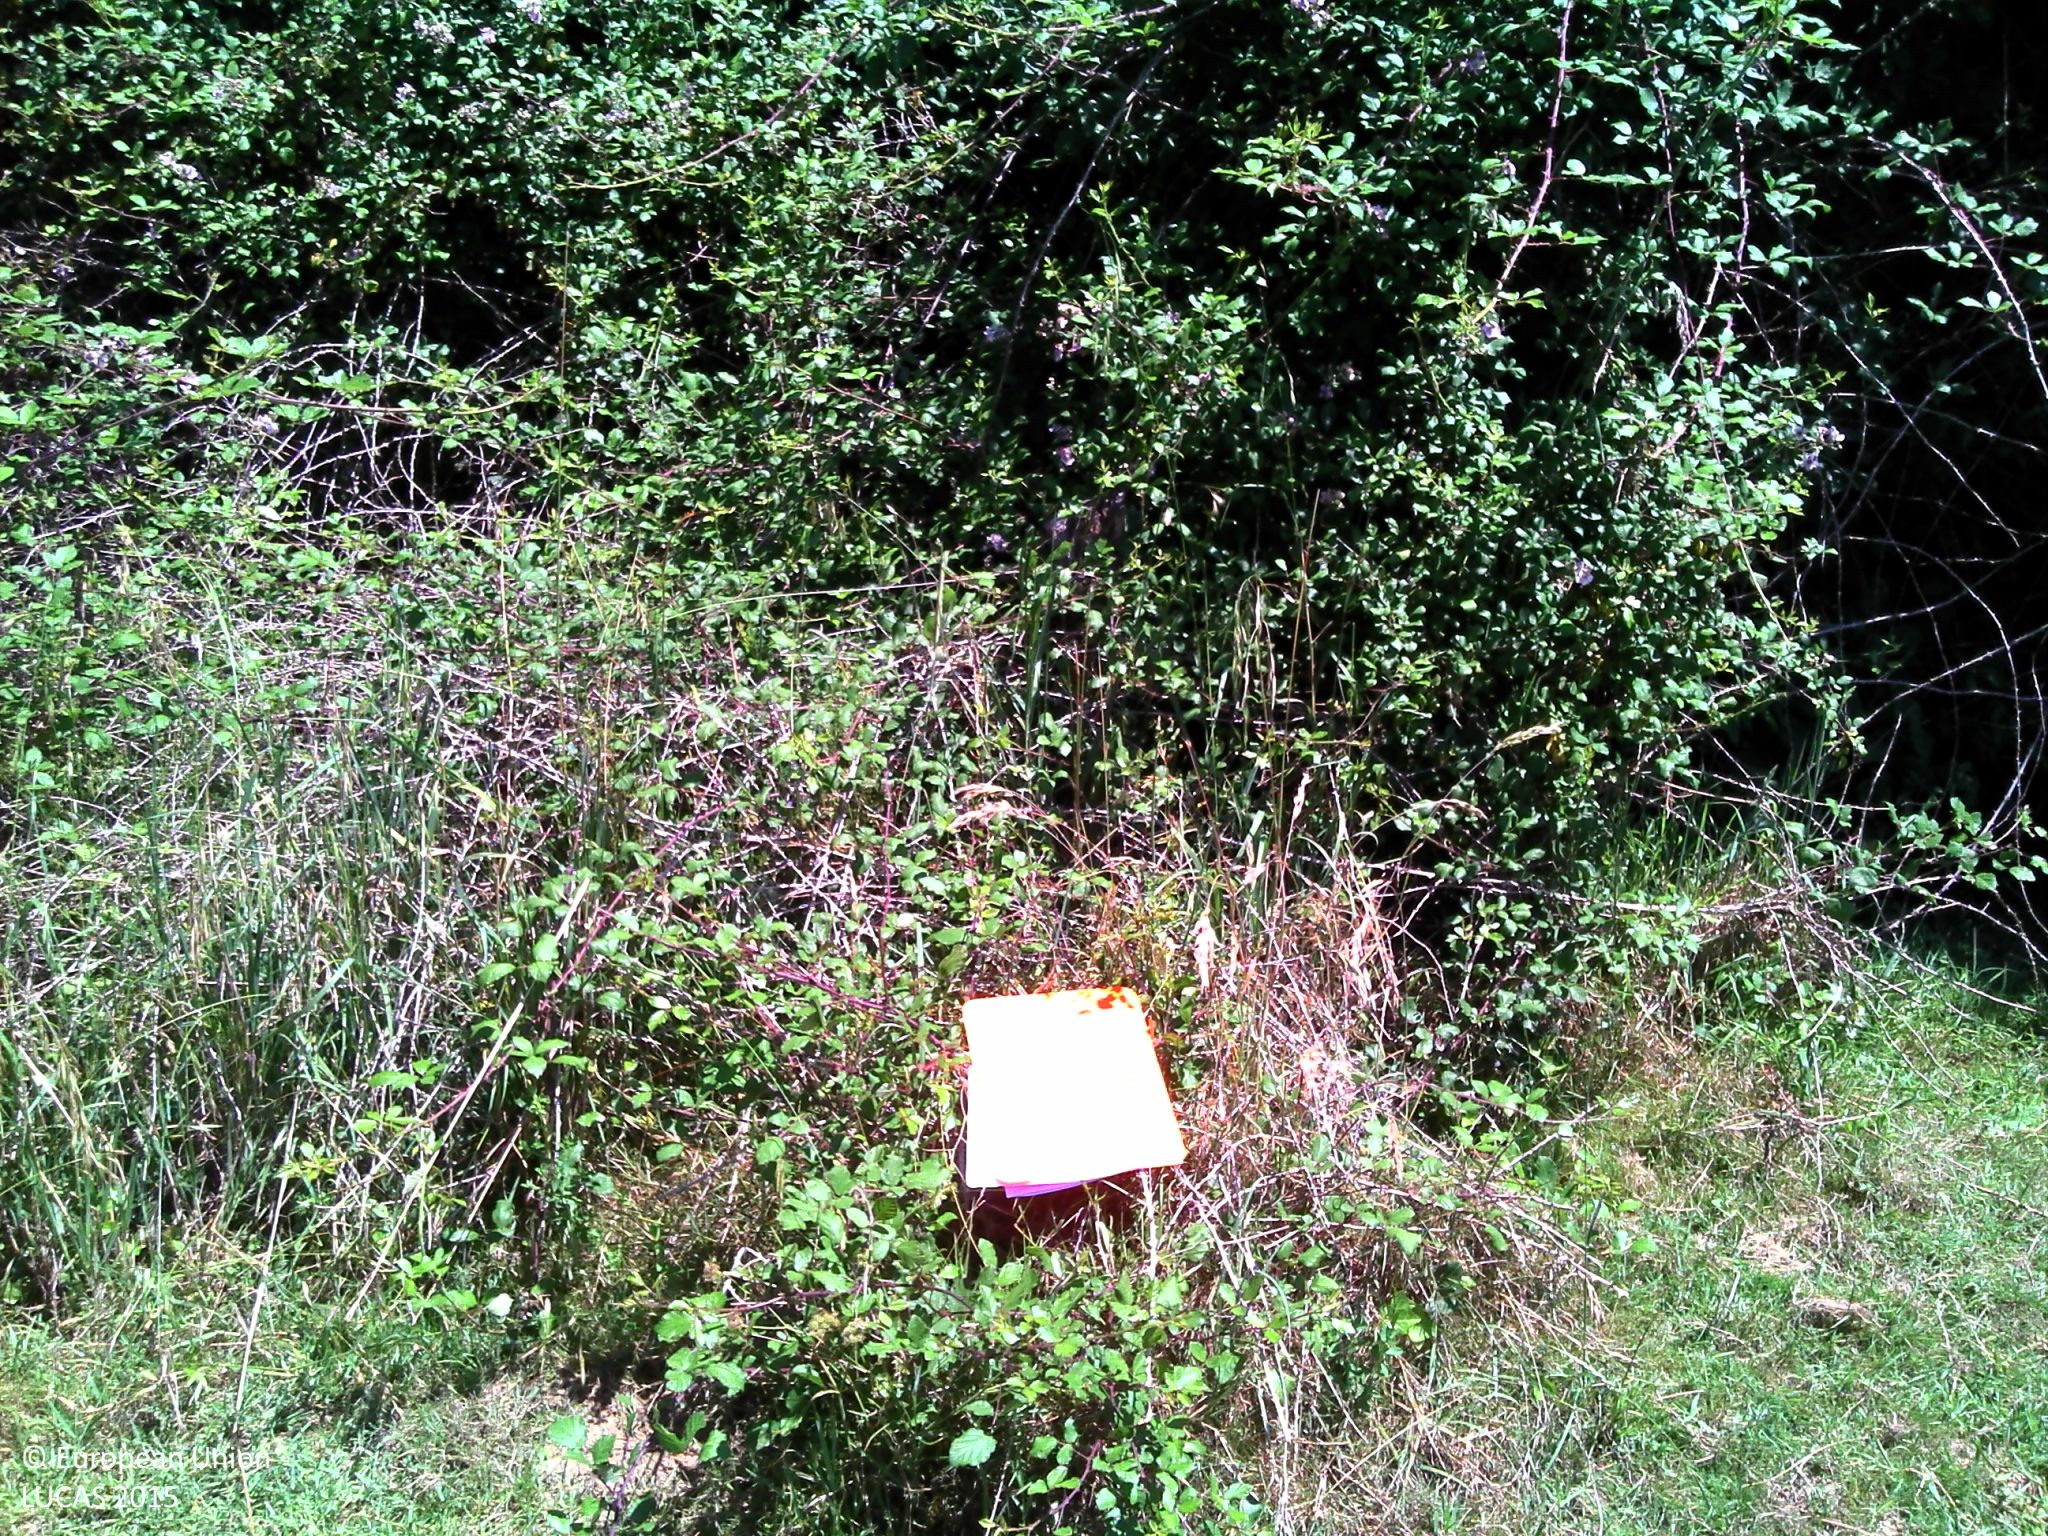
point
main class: Grassland
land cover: Grassland with sparse tree/shrub cover
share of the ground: > 75 %
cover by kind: herbaceous plants 85 %, shrubs 10 %, broadleaved forest trees 5 %
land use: Agriculture (excluding fallow land and kitchen gardens)
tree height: < 5 m
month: June
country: FR
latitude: 43.7280
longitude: -0.4758
